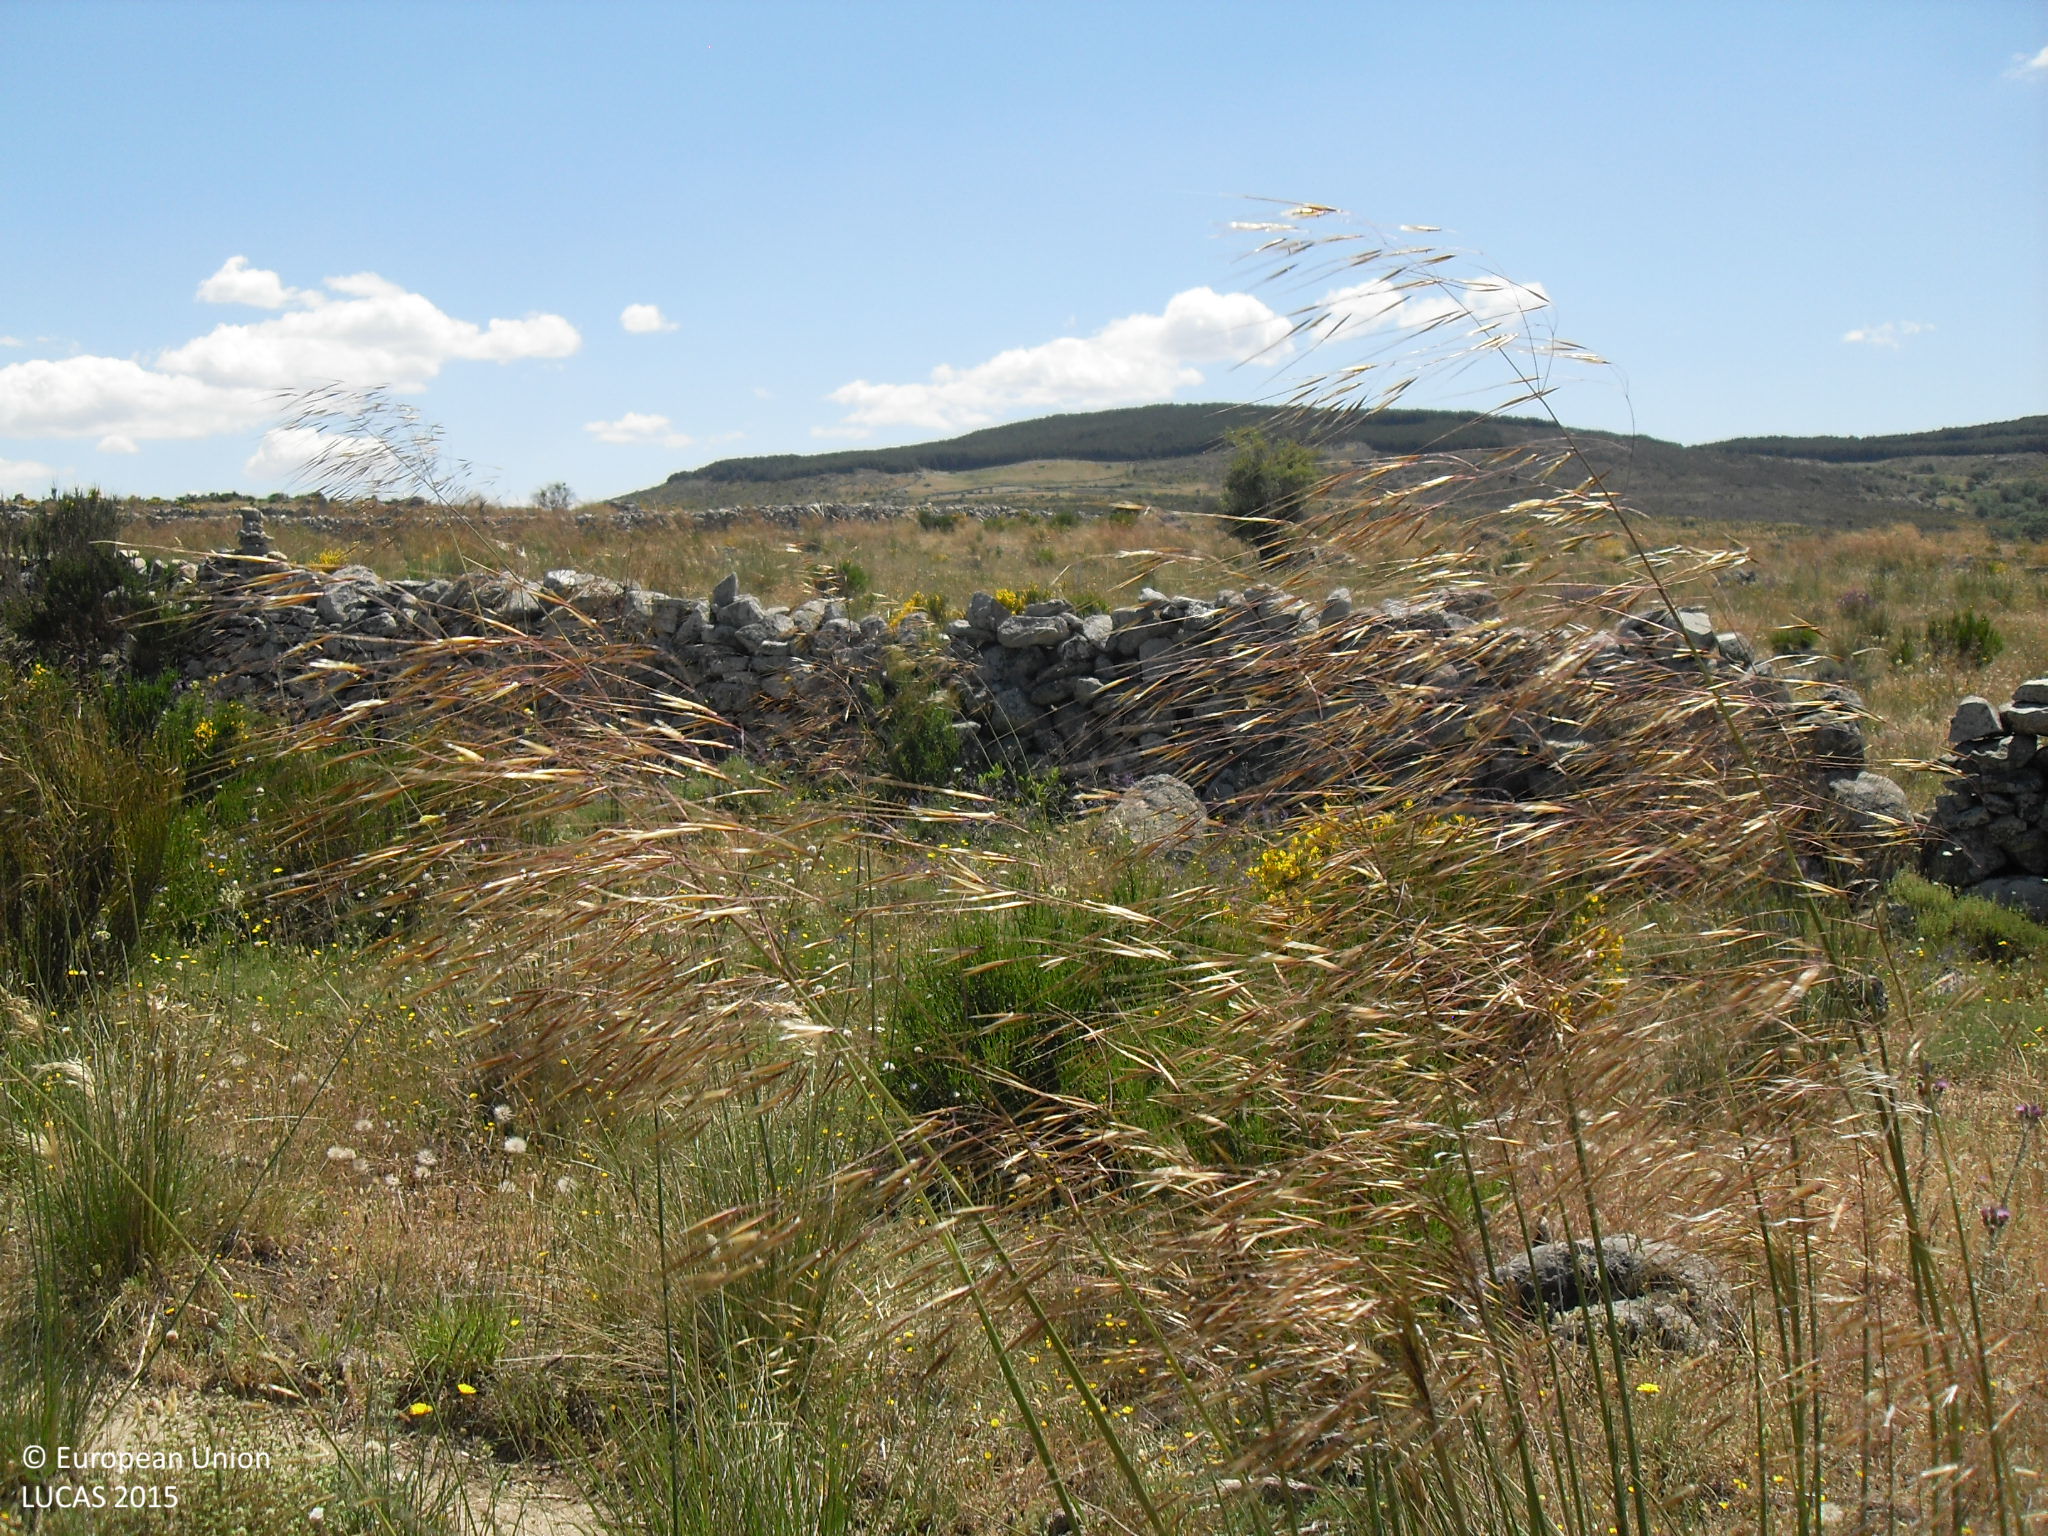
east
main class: Grassland
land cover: Grassland without tree/shrub cover
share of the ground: > 75 %
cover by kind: herbaceous plants 100 %
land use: Agriculture (excluding fallow land and kitchen gardens)
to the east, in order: Grassland without tree/shrub cover; Dry stone walls; Grassland without tree/shrub cover; Dry stone walls; Grassland without tree/shrub cover; Dry stone walls; Grassland without tree/shrub cover
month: June
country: ES
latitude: 40.5887
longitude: -5.2708
